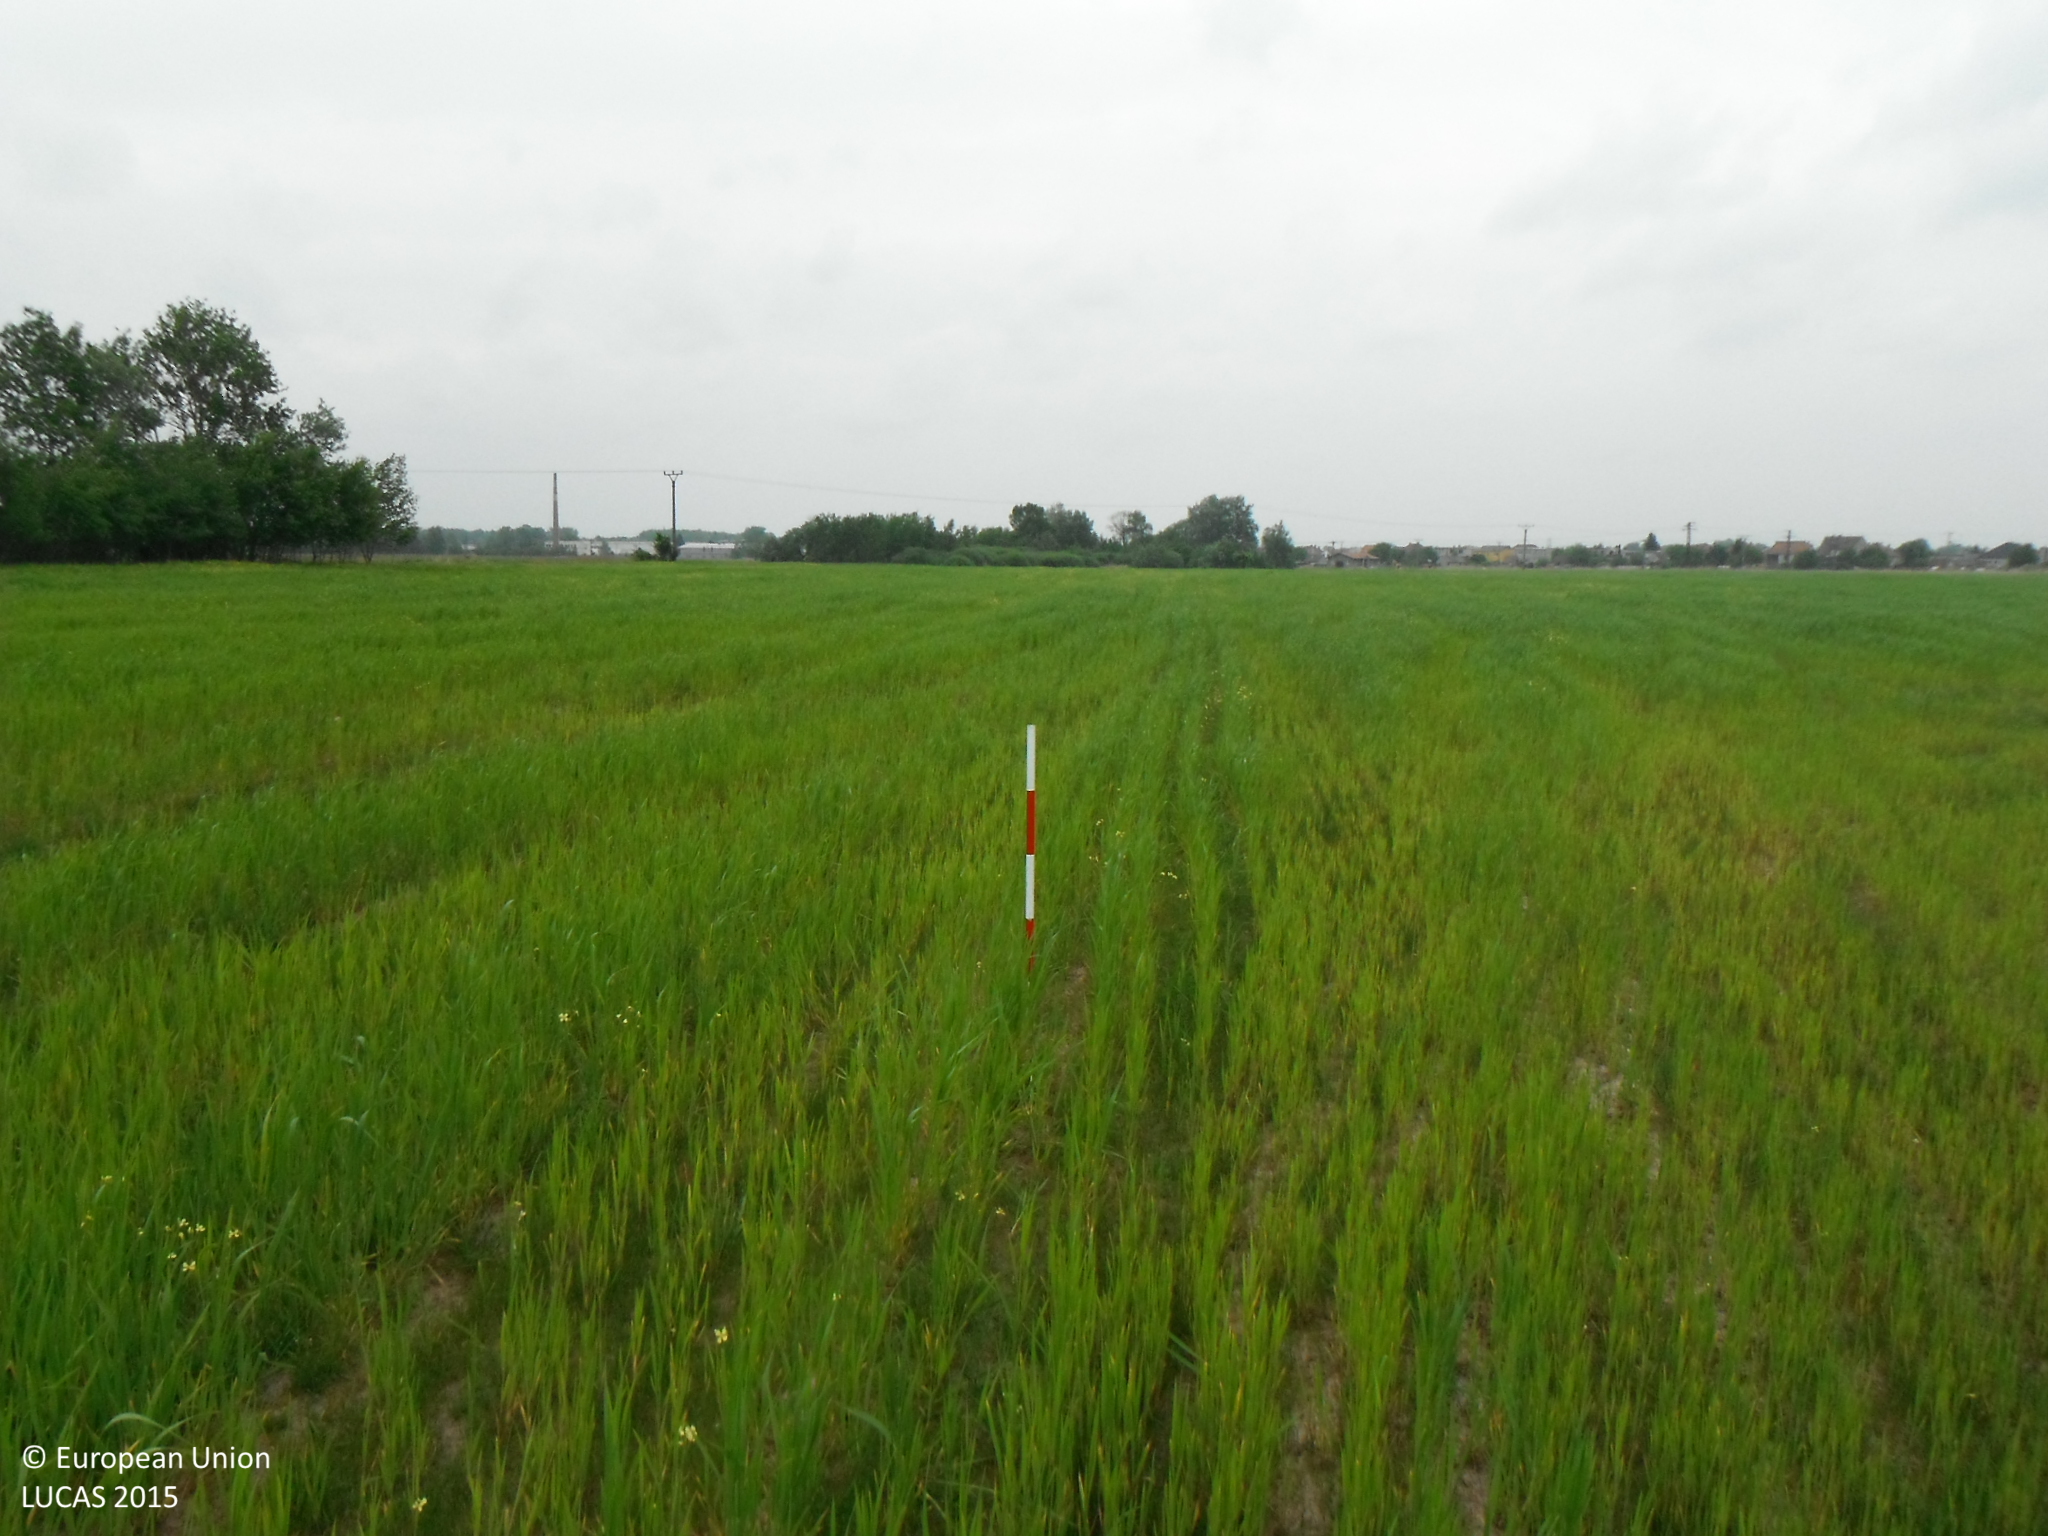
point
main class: Cropland
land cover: Rye
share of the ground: 50 - 75 %
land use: Agriculture (excluding fallow land and kitchen gardens)
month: May
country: SK
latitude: 48.6673
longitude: 17.0286
